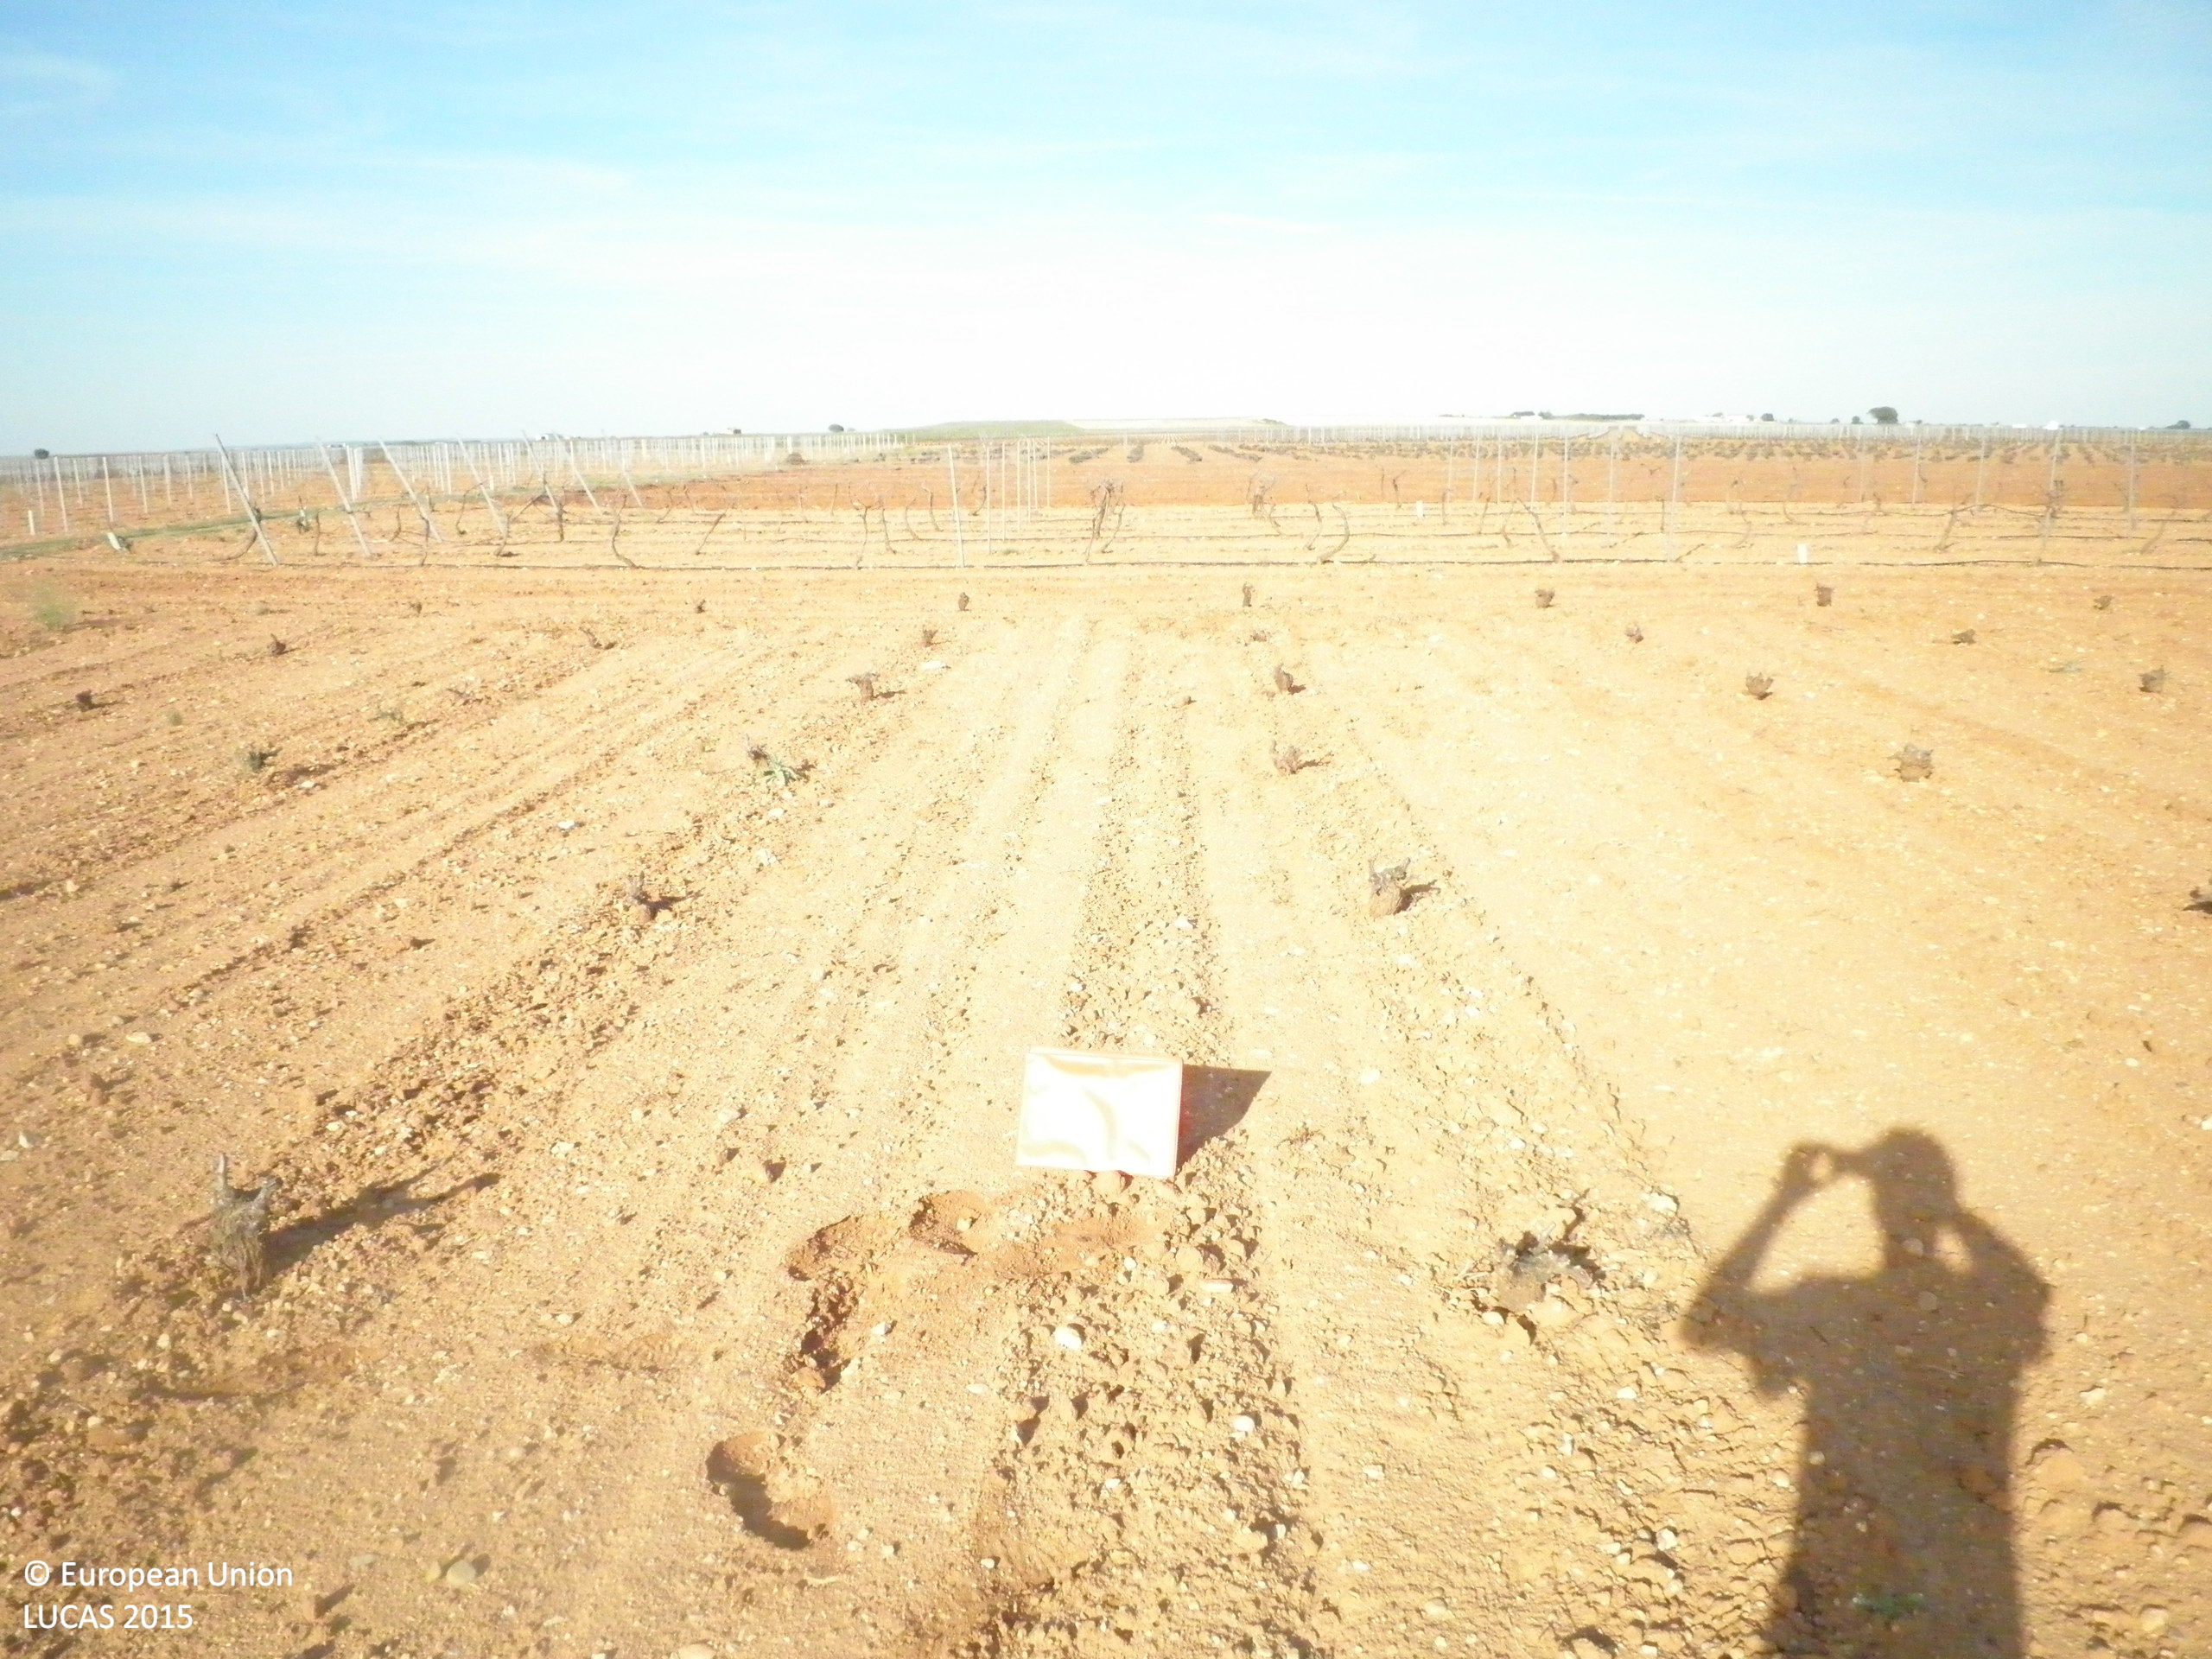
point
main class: Cropland
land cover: Vineyards
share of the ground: < 10 %
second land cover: Other bare soil
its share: > 75 %
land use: Agriculture (excluding fallow land and kitchen gardens)
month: April
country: ES
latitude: 39.3594
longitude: -2.7440
